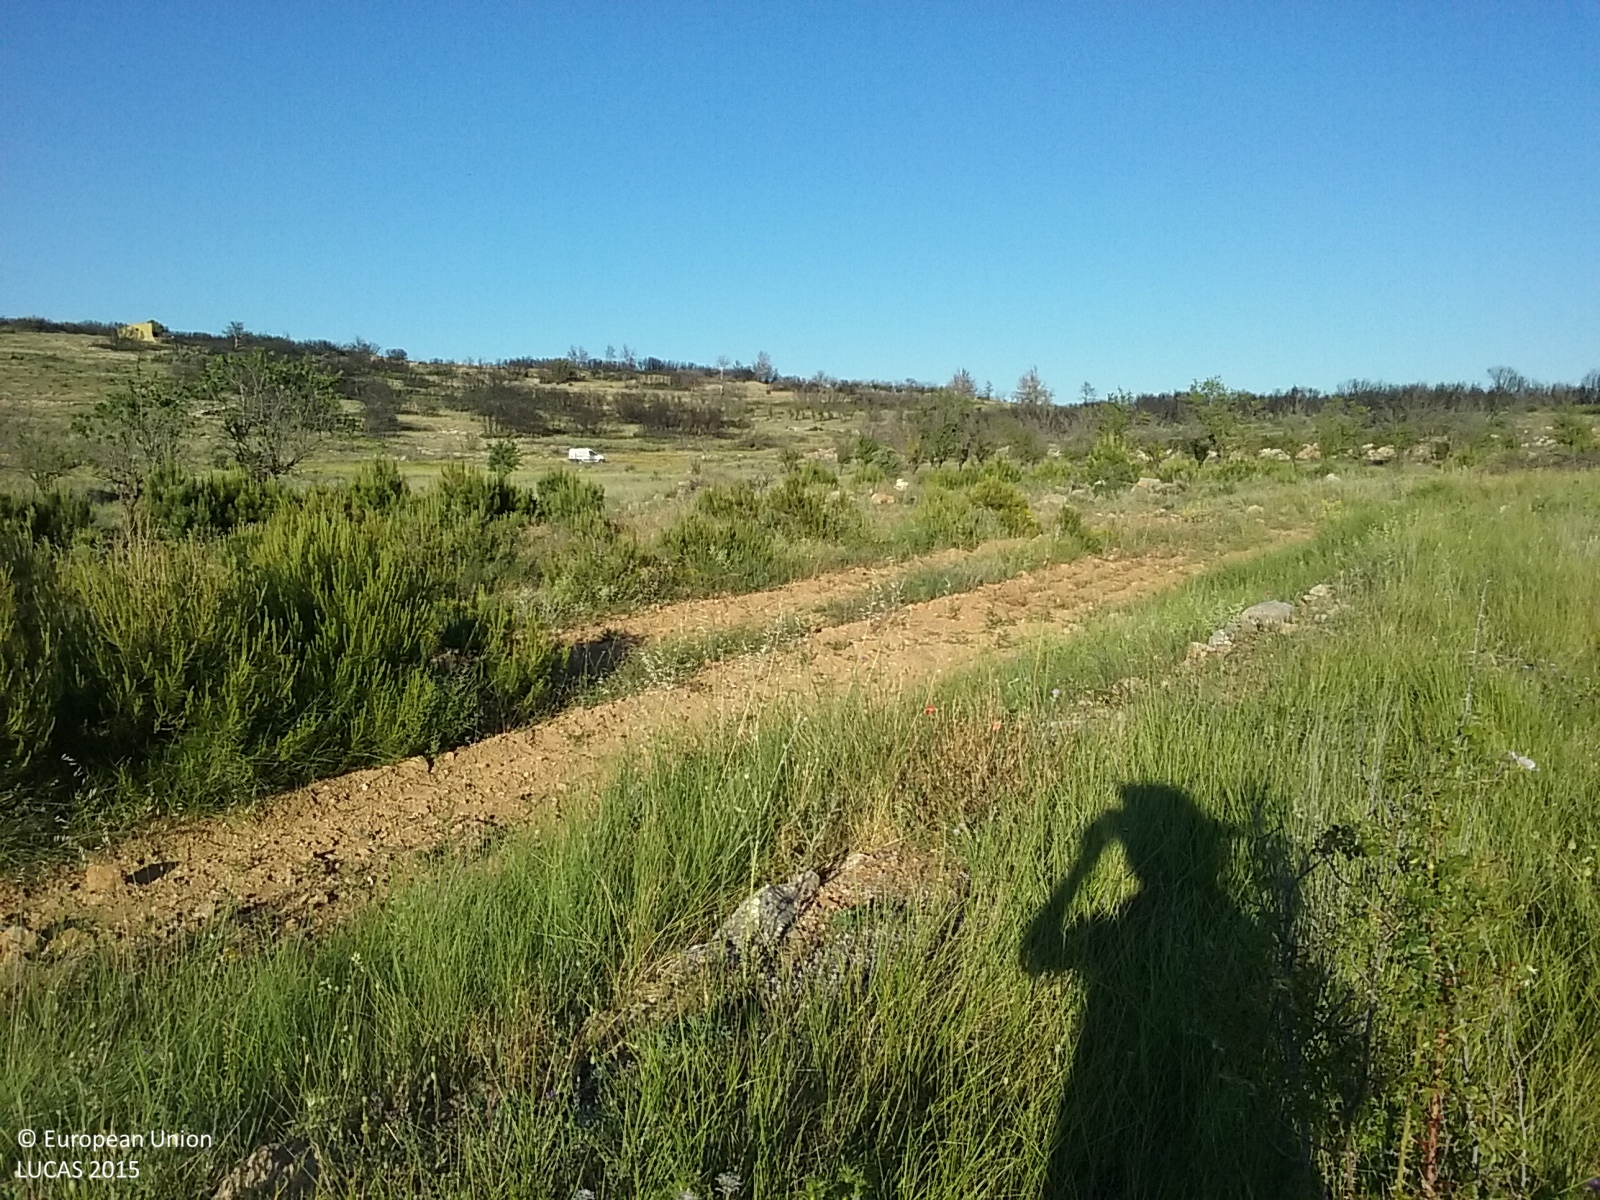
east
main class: Grassland
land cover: Spontaneously vegetated surfaces
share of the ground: > 75 %
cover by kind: herbaceous plants 90 %, shrubs 5 %, unconsolidated bare surface 5 %
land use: Abandoned areas
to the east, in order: Spontaneously vegetated surfaces; Dry stone walls; Shrubland without tree cover; Dry stone walls; Shrubland without tree cover; Grassland without tree/shrub cover; Dry stone walls; Grassland without tree/shrub cover; Shrubland without tree cover; Tracks; Shrubland without tree cover; Tracks; Shrubland without tree cover; Tracks; Shrubland without tree cover
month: June
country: ES
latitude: 39.8450
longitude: -0.6963
